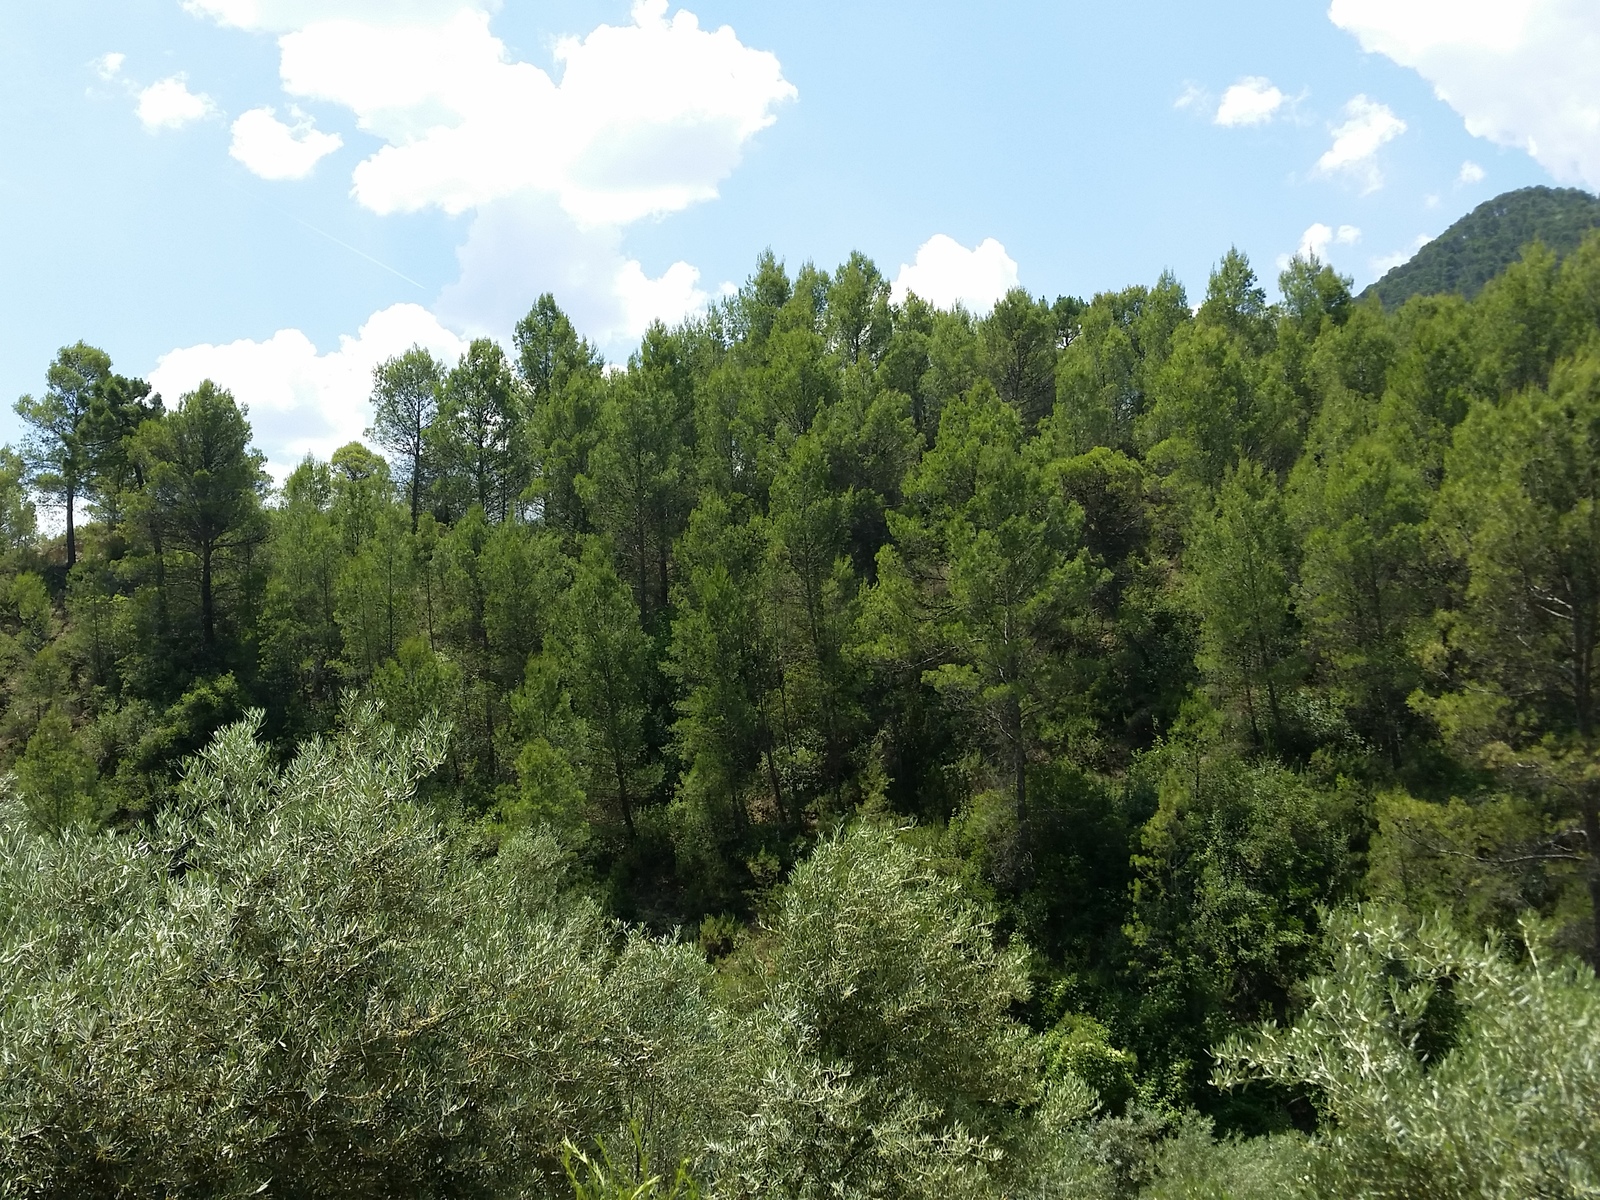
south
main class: Cropland
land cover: Olive groves
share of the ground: 50 - 75 %
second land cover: Other bare soil
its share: > 75 %
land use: Agriculture (excluding fallow land and kitchen gardens)
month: June
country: ES
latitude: 38.3747
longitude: -2.5777
